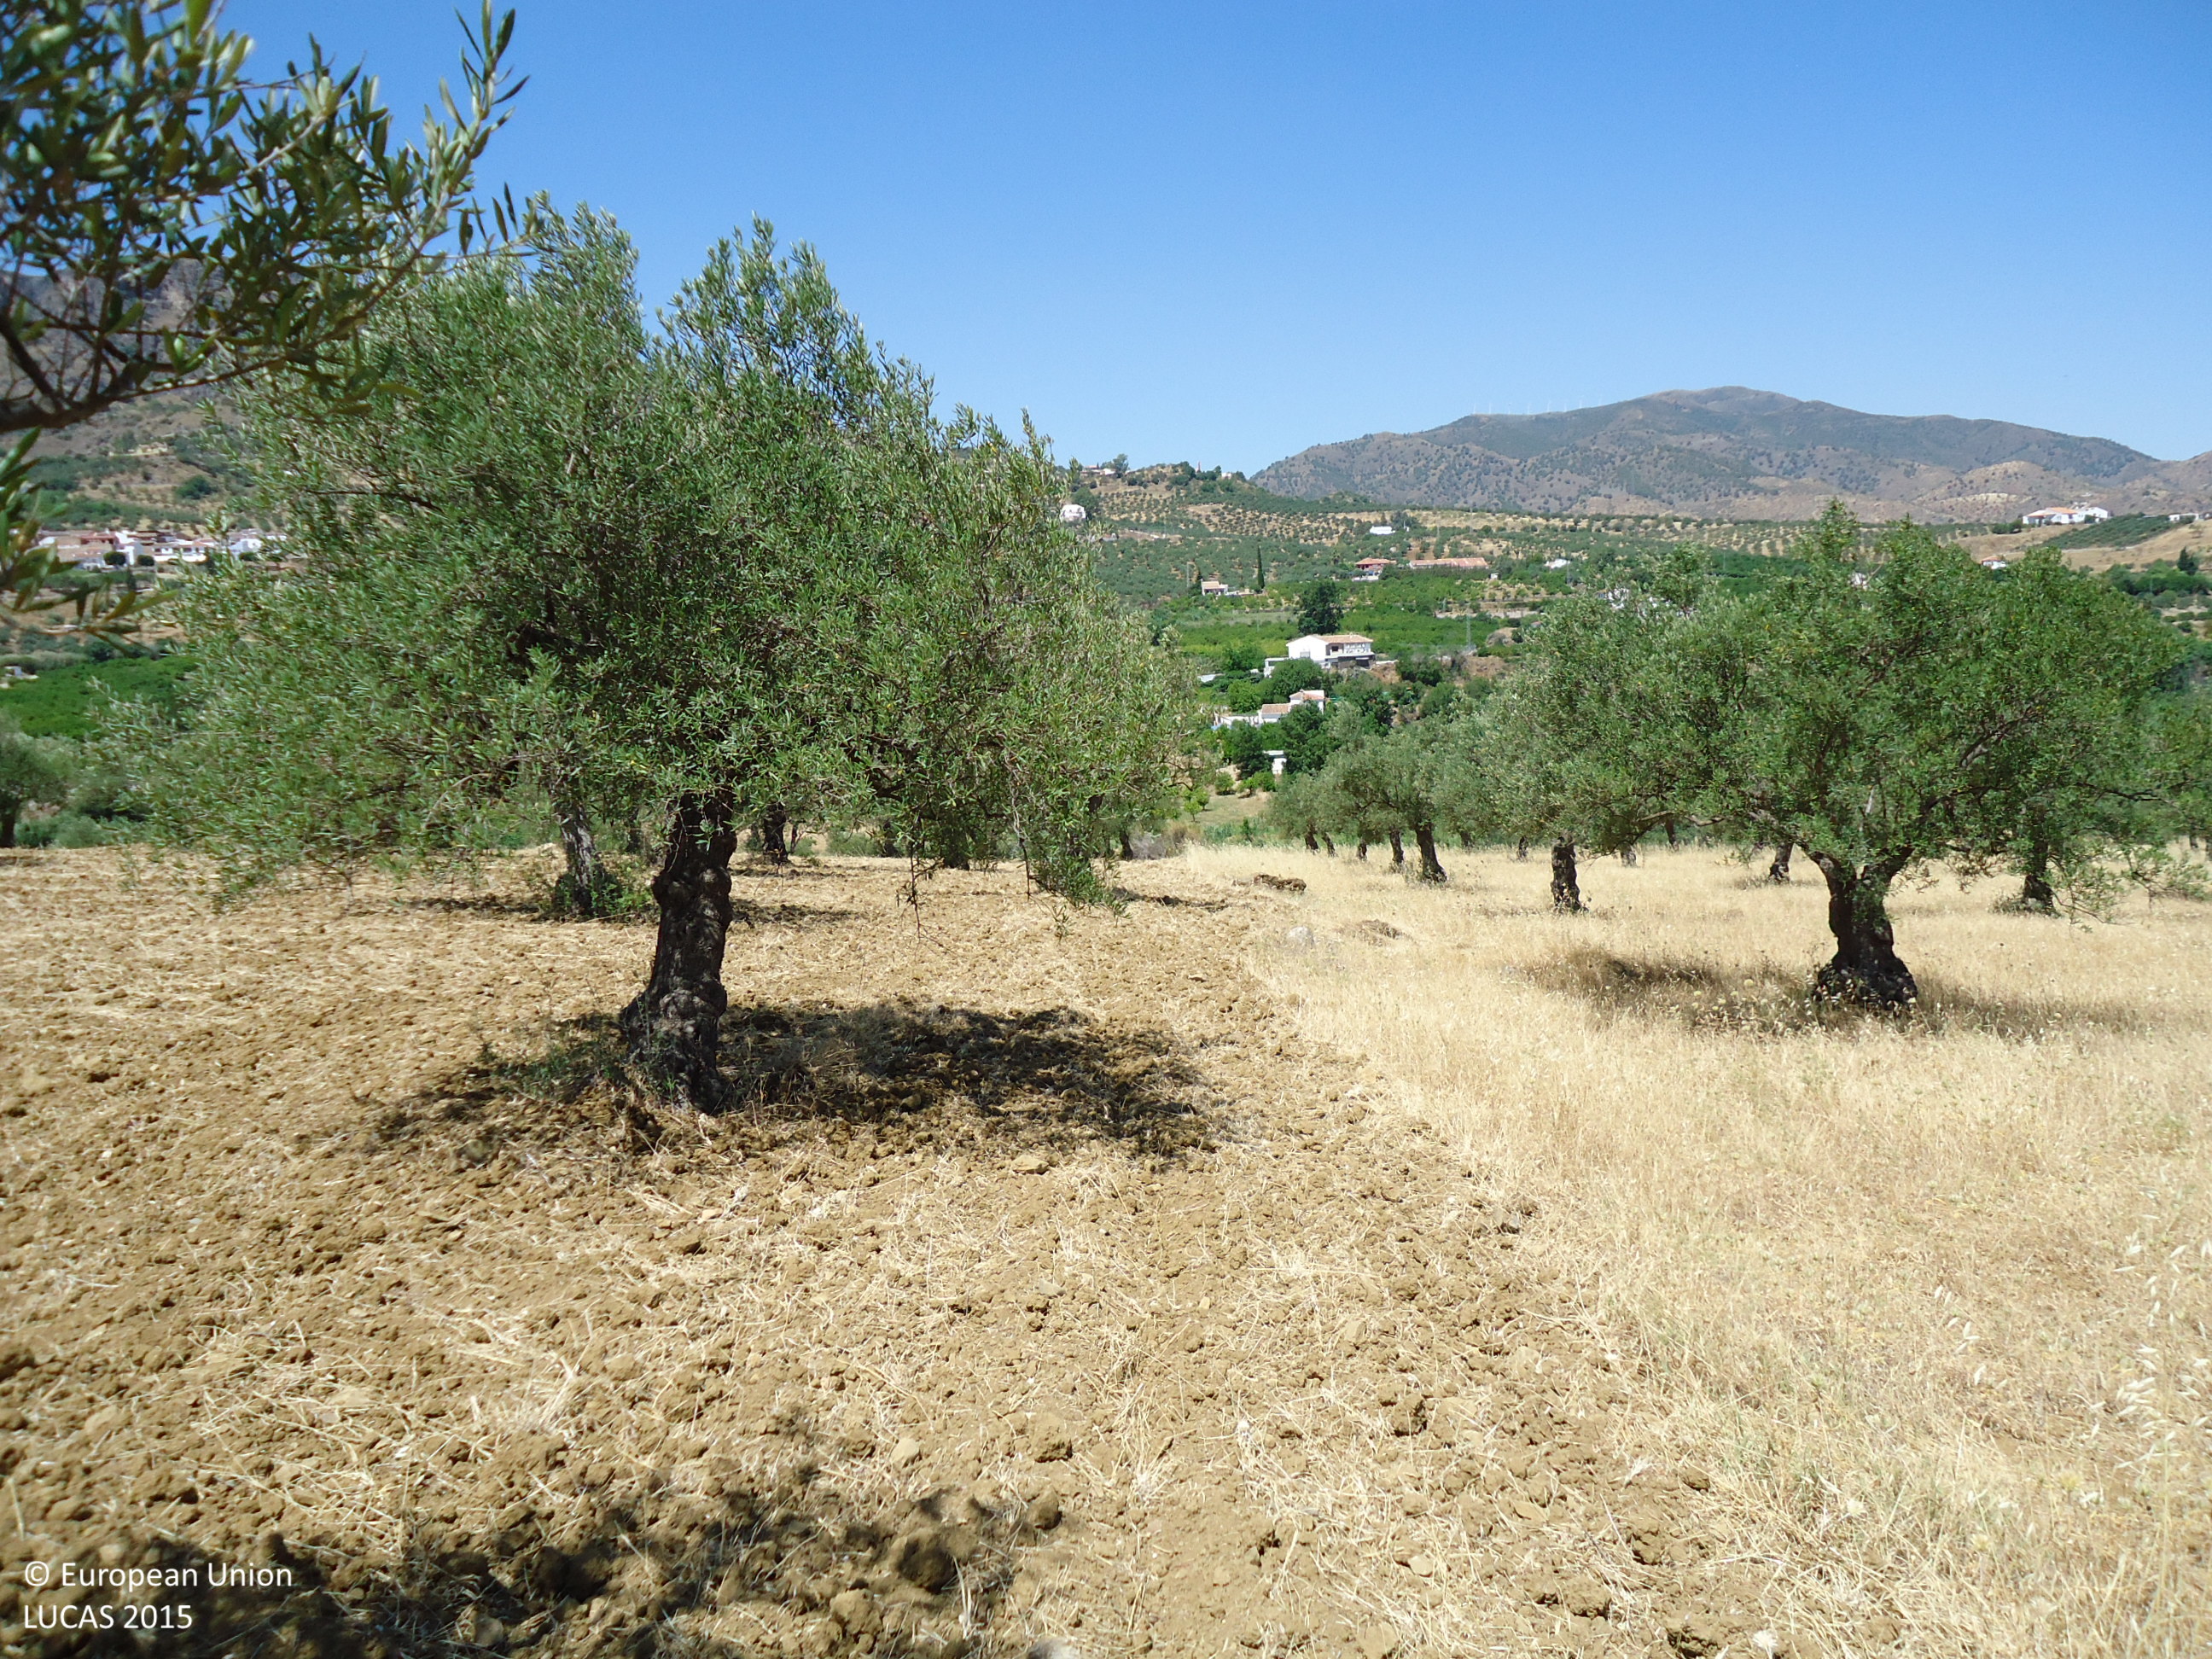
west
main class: Cropland
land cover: Olive groves
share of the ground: 25 - 50 %
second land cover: Other bare soil
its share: > 75 %
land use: Agriculture (excluding fallow land and kitchen gardens)
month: June
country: ES
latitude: 36.8383
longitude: -4.6957
